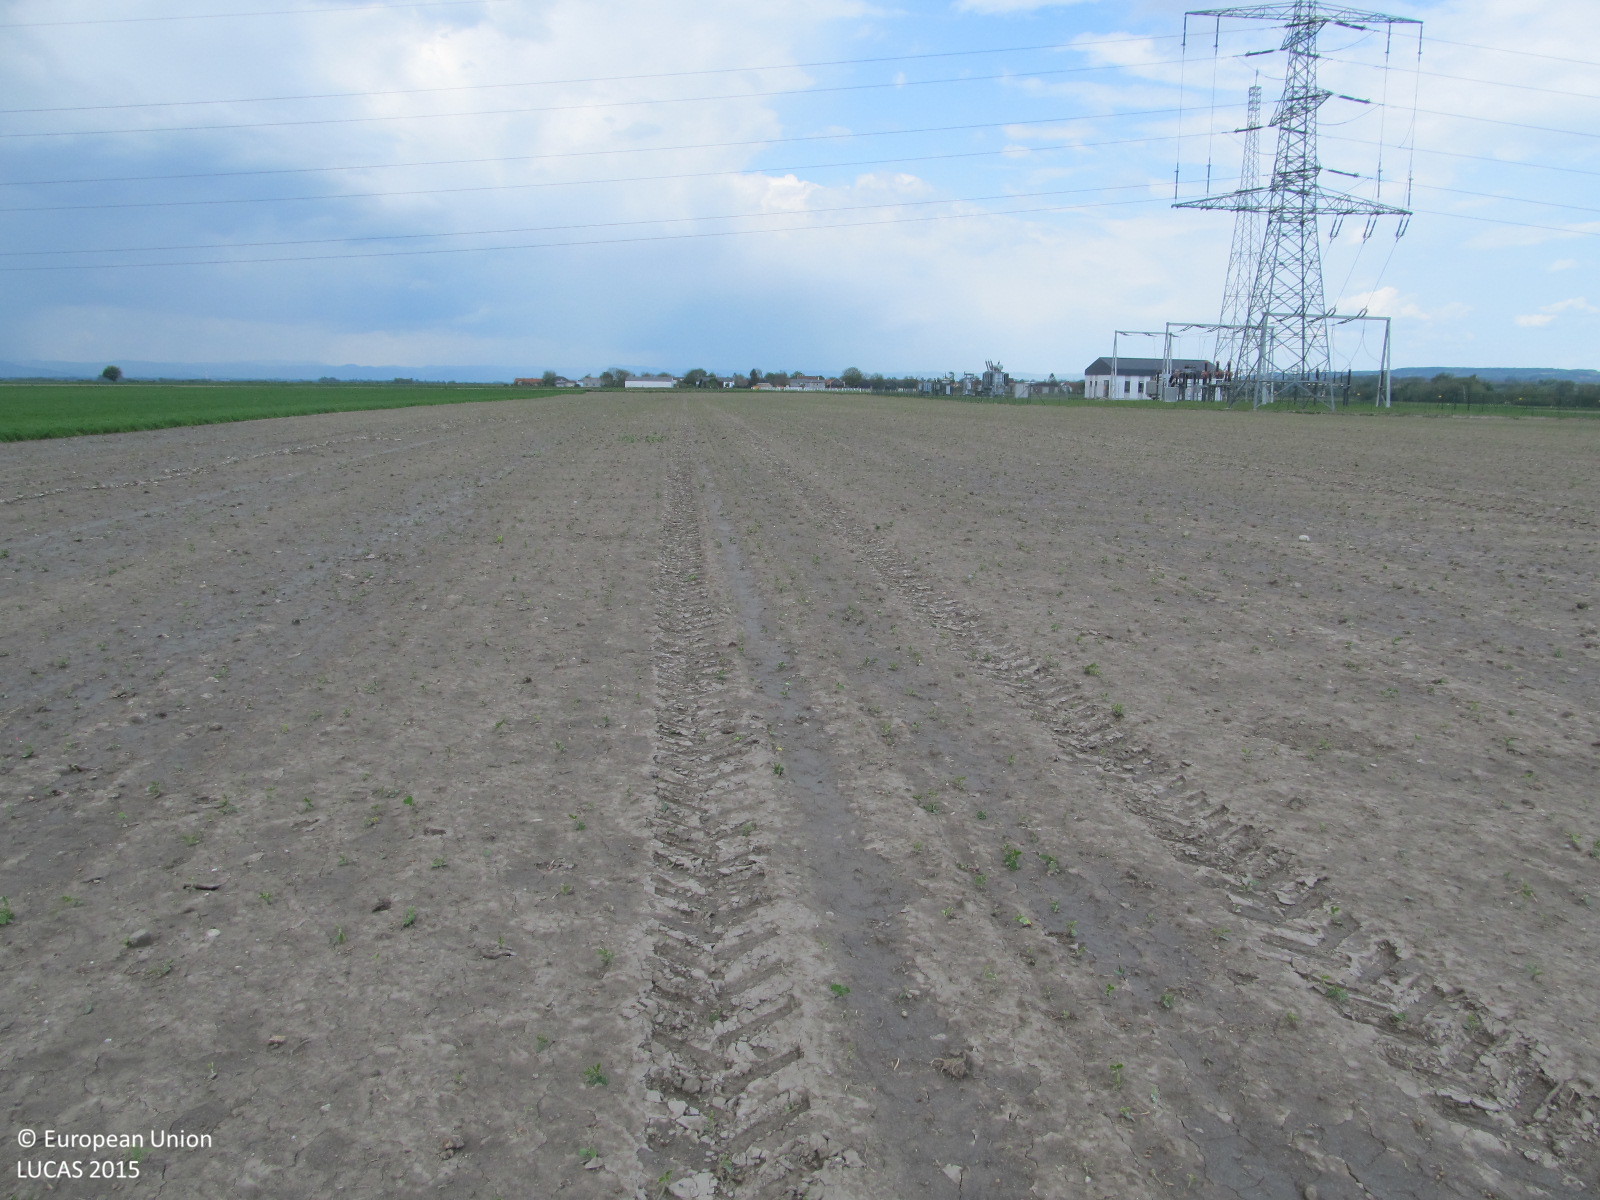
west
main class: Artificial land
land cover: Other artificial areas
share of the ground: > 75 %
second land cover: Soya
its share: < 10 %
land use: Electricity, gas and thermal power distribution
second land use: Agriculture (excluding fallow land and kitchen gardens)
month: May
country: AT
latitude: 48.4273
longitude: 15.8825
